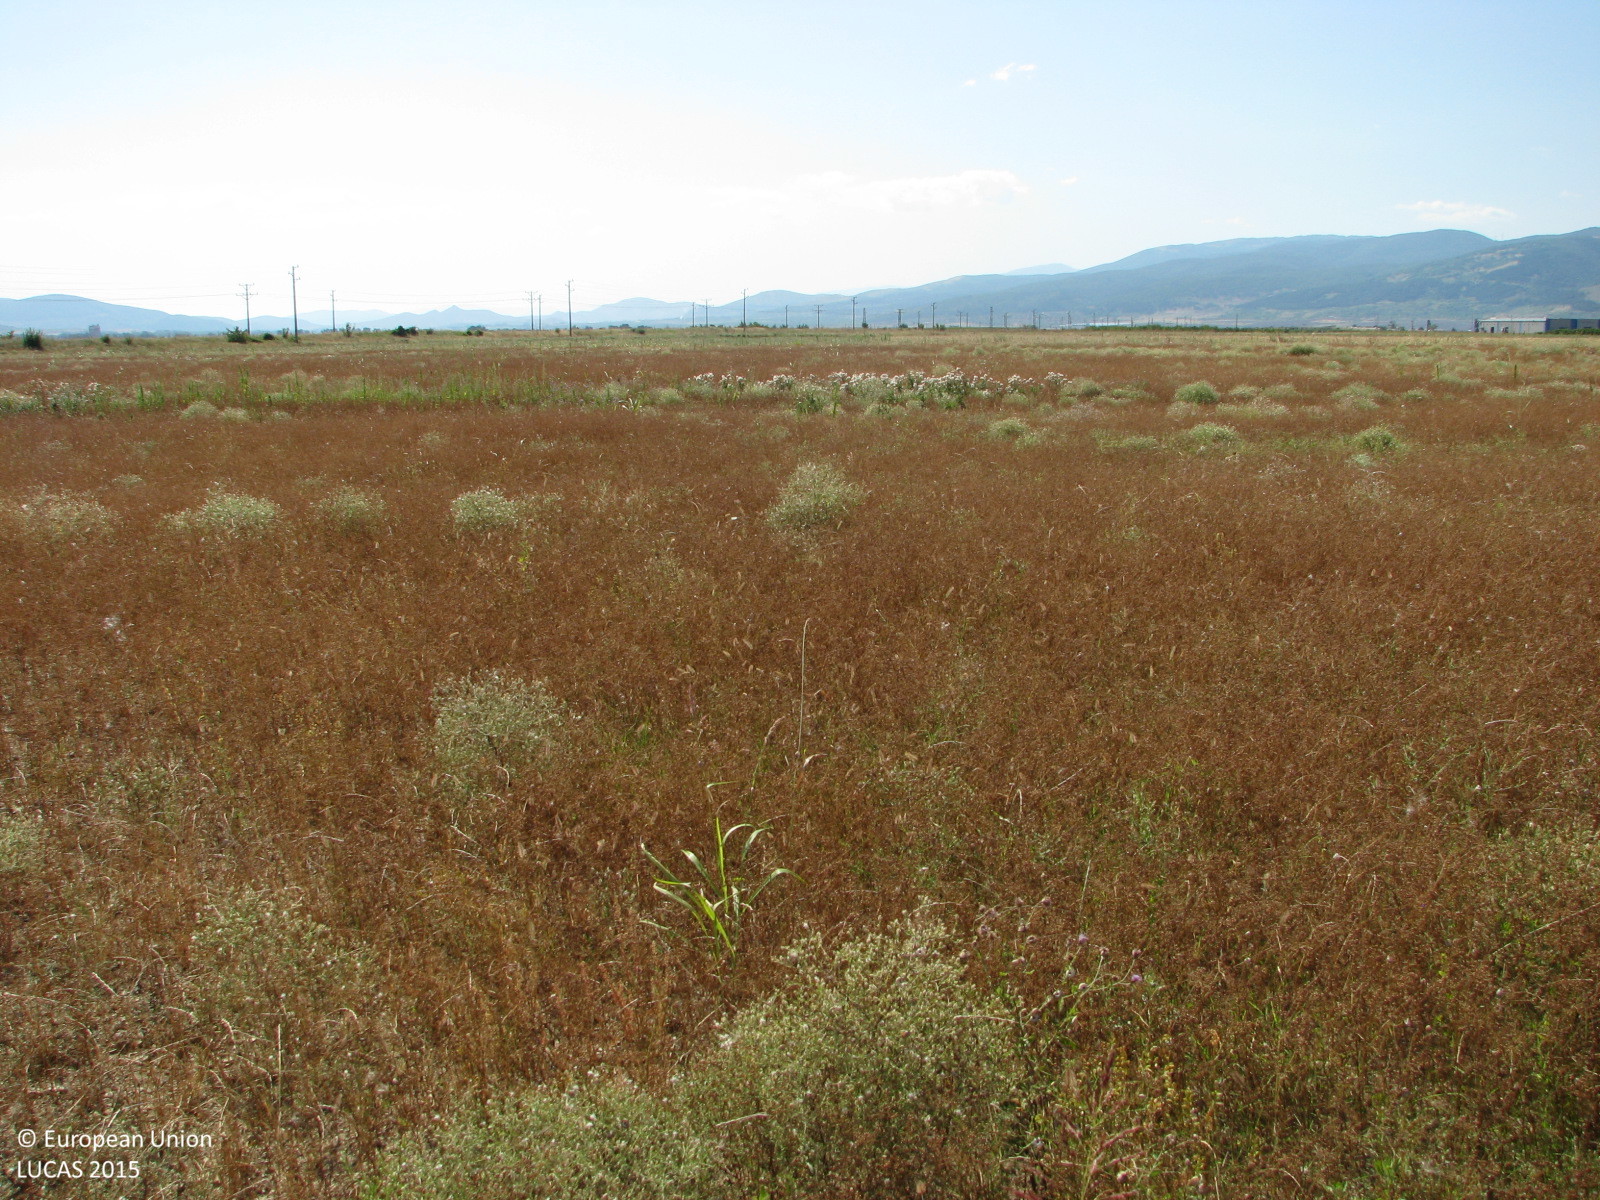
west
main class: Cropland
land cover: Other non-permanent industrial crops
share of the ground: > 75 %
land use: Agriculture (excluding fallow land and kitchen gardens)
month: July
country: BG
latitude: 42.6255
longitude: 26.3184
